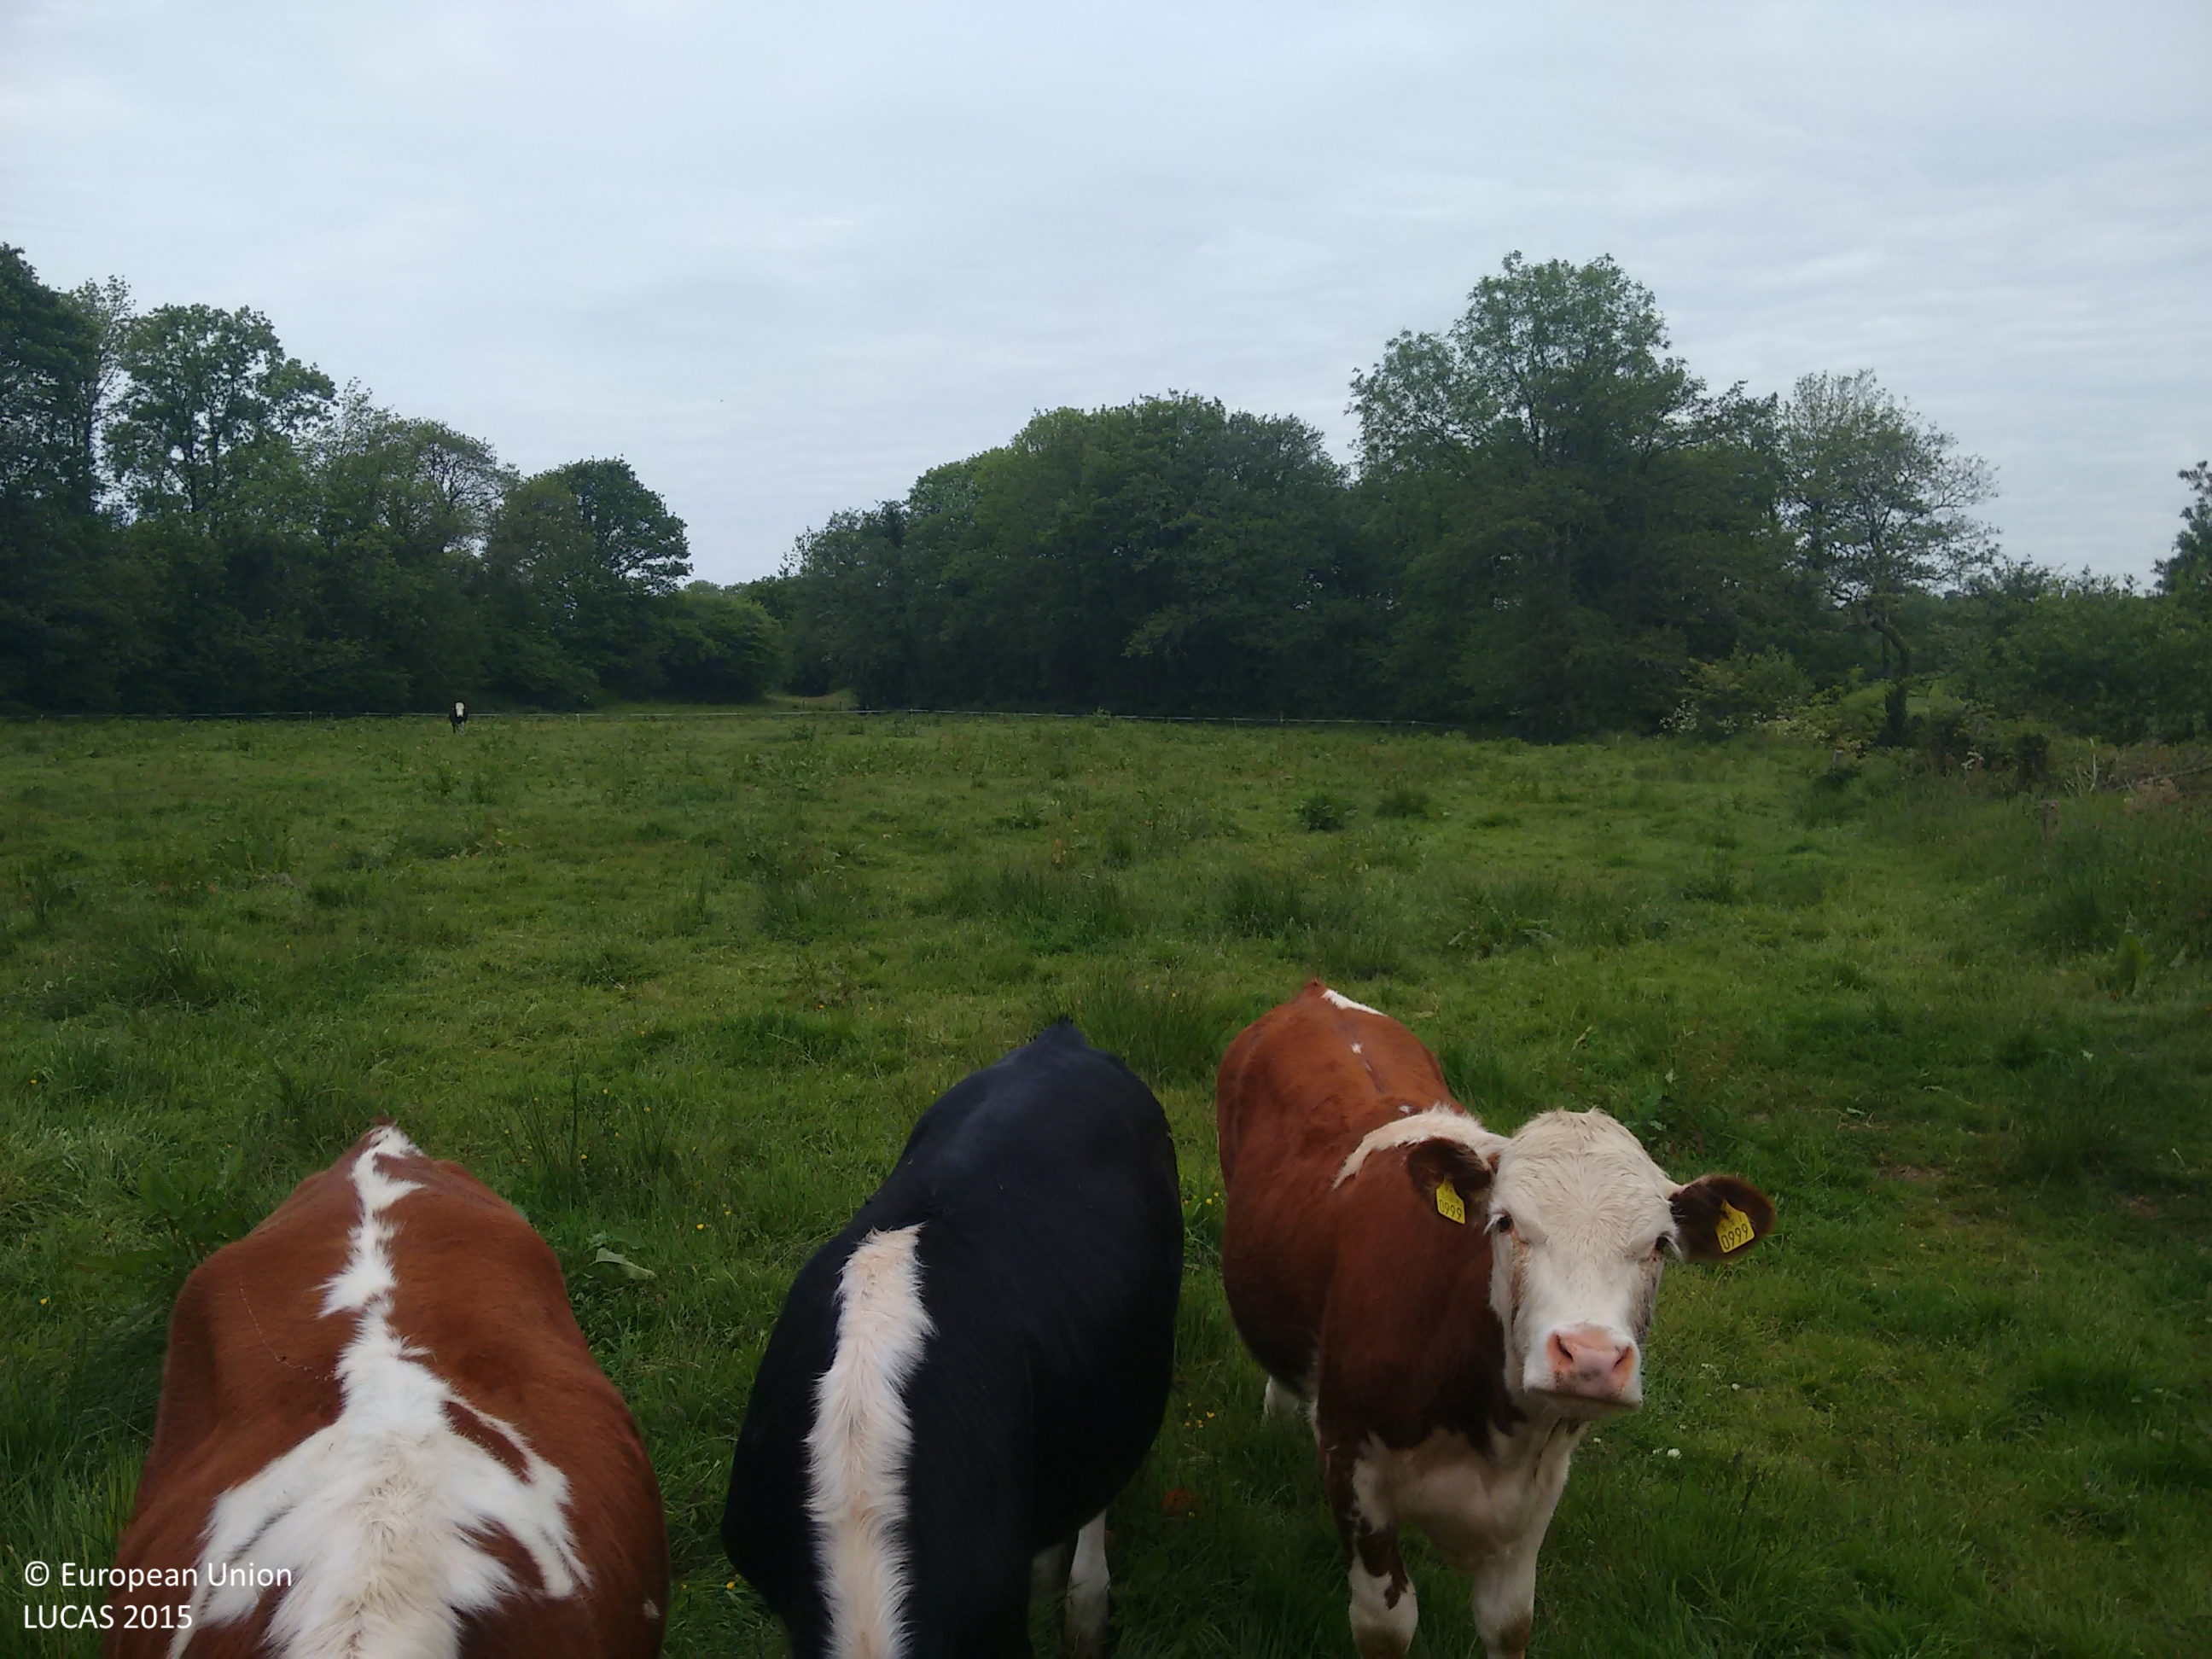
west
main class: Grassland
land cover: Grassland without tree/shrub cover
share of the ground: > 75 %
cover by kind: herbaceous plants 100 %
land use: Agriculture (excluding fallow land and kitchen gardens)
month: June
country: IE
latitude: 52.0513
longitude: -8.3738
